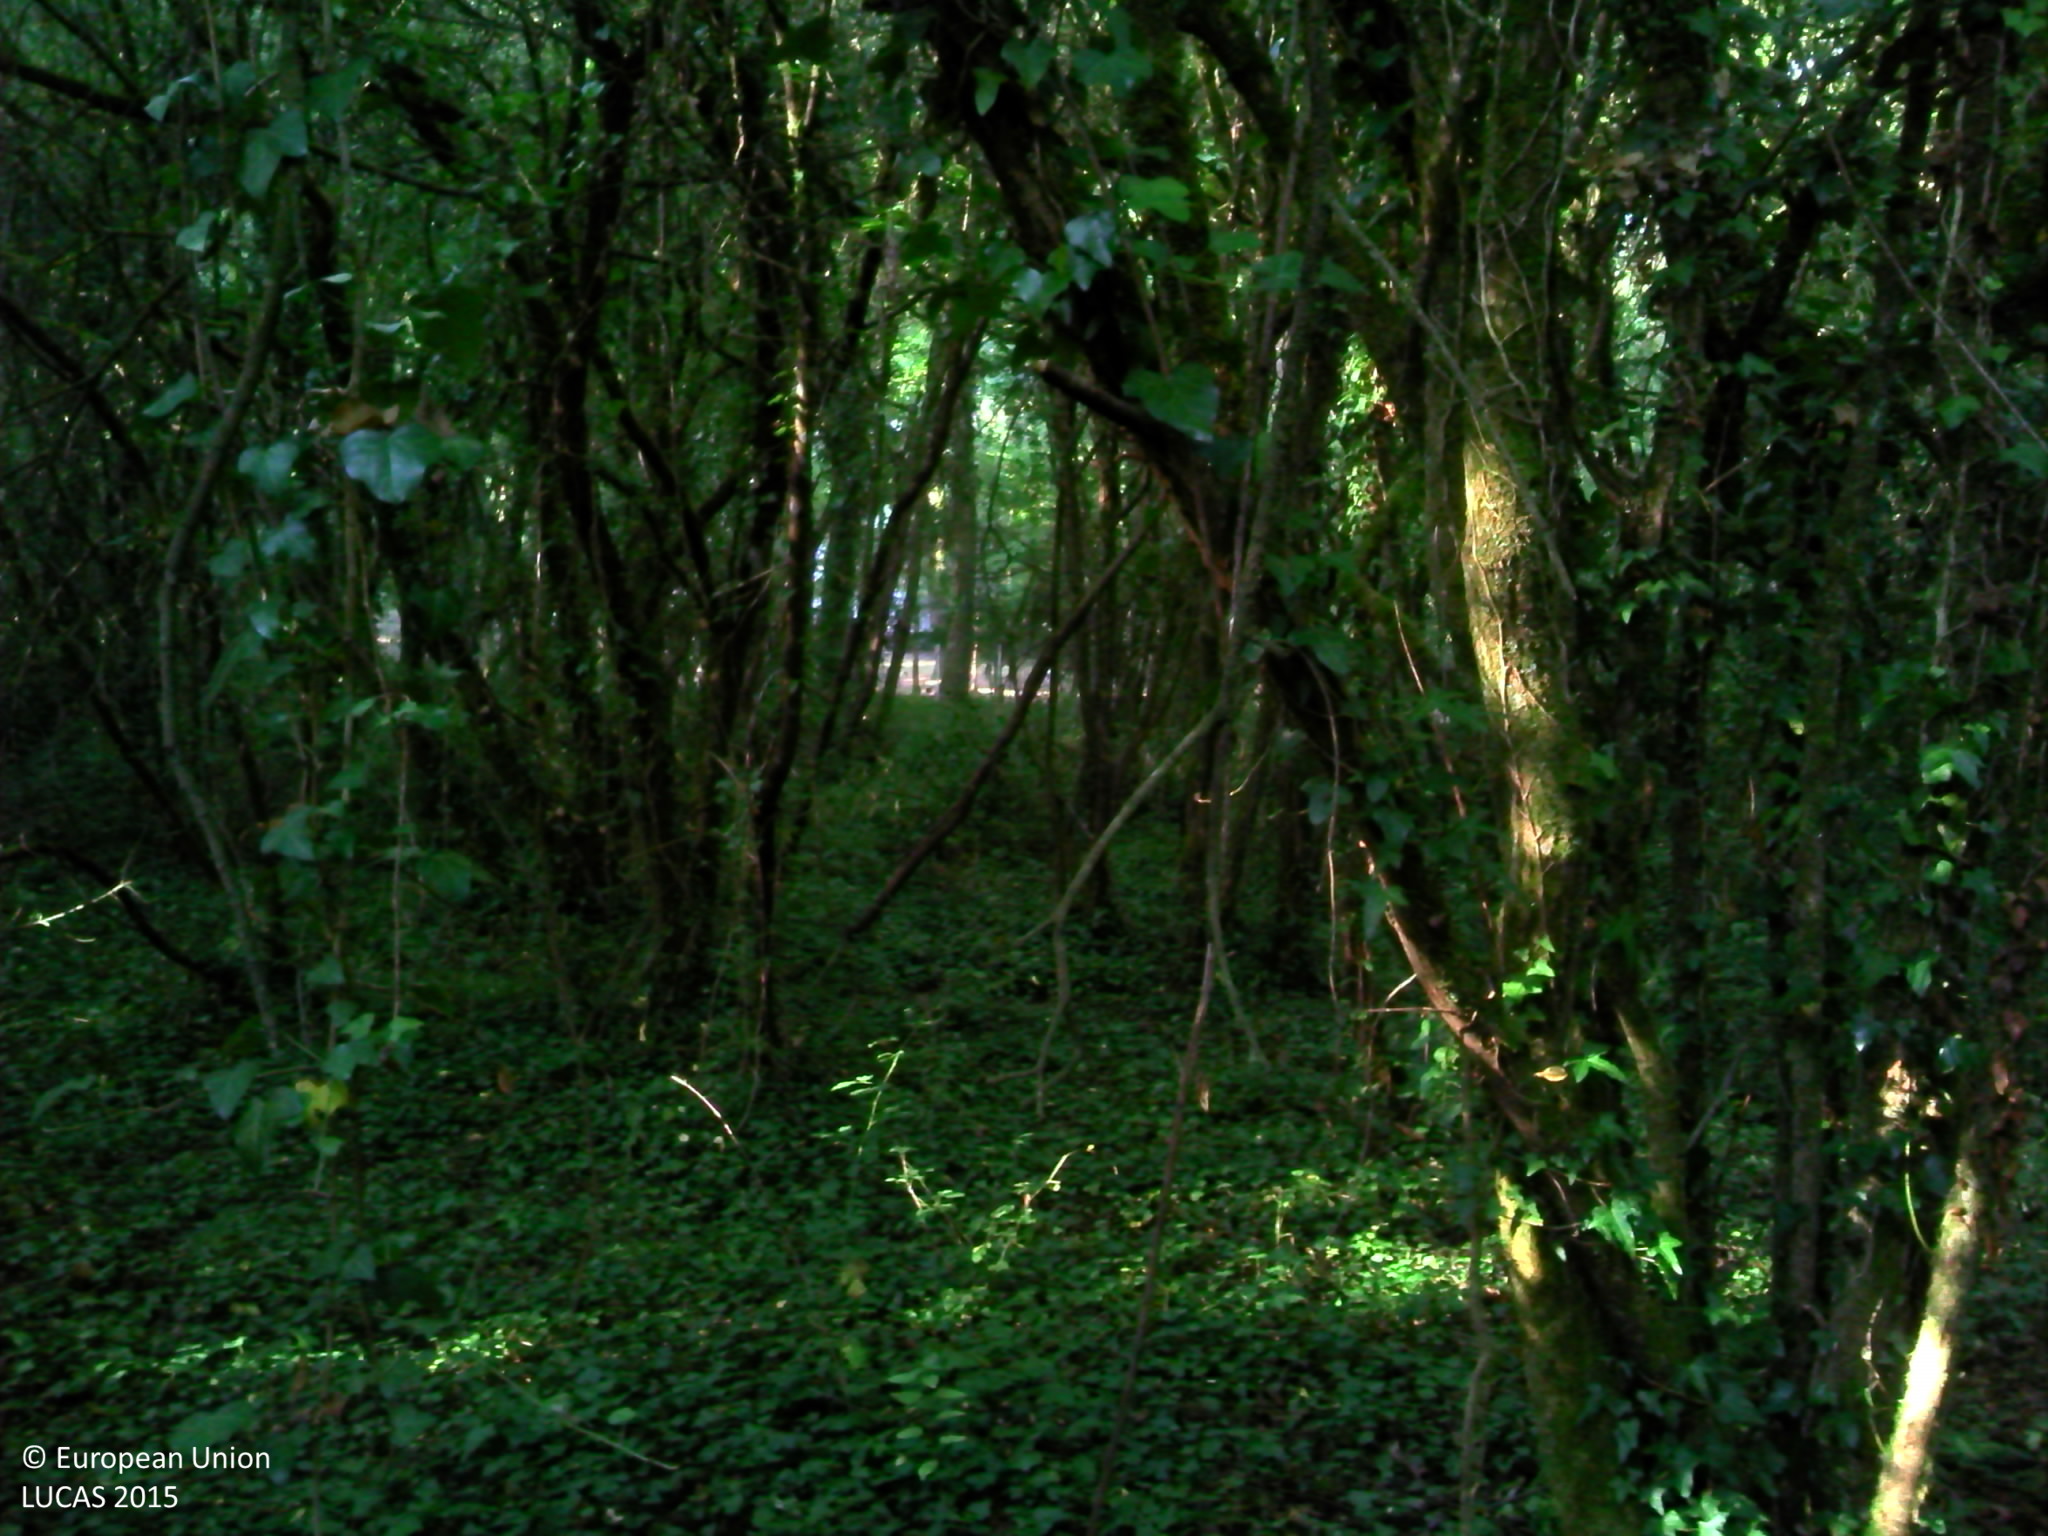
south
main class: Woodland
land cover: Broadleaved woodland
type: mesophytic deciduous forest
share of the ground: > 75 %
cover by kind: broadleaved forest trees 95 %, herbaceous plants 5 %
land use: Semi-natural and natural areas not in use
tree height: > 5 m
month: August
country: FR
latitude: 47.3584
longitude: -1.8970
